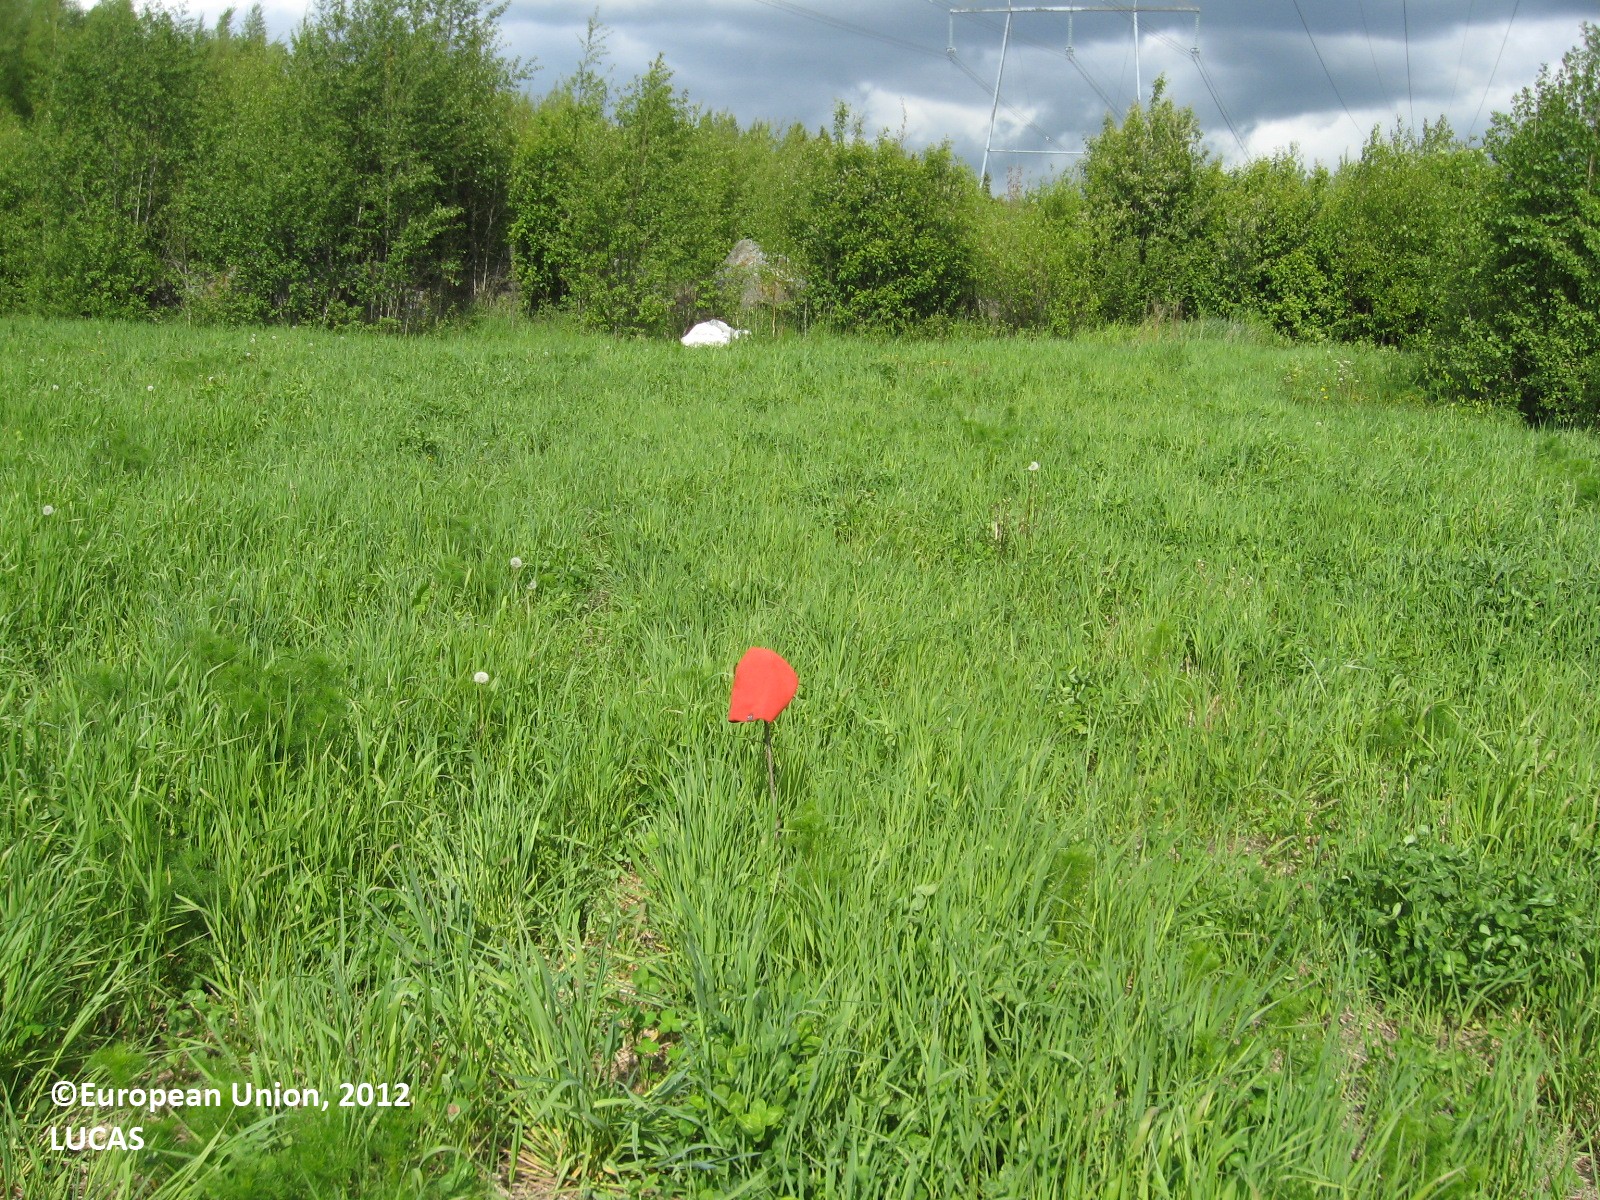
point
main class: Grassland
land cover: Grassland without tree/shrub cover
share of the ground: > 75 %
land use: Agriculture (excluding fallow land and kitchen gardens)
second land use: Energy production
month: June
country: FI
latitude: 63.0709
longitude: 21.8986
